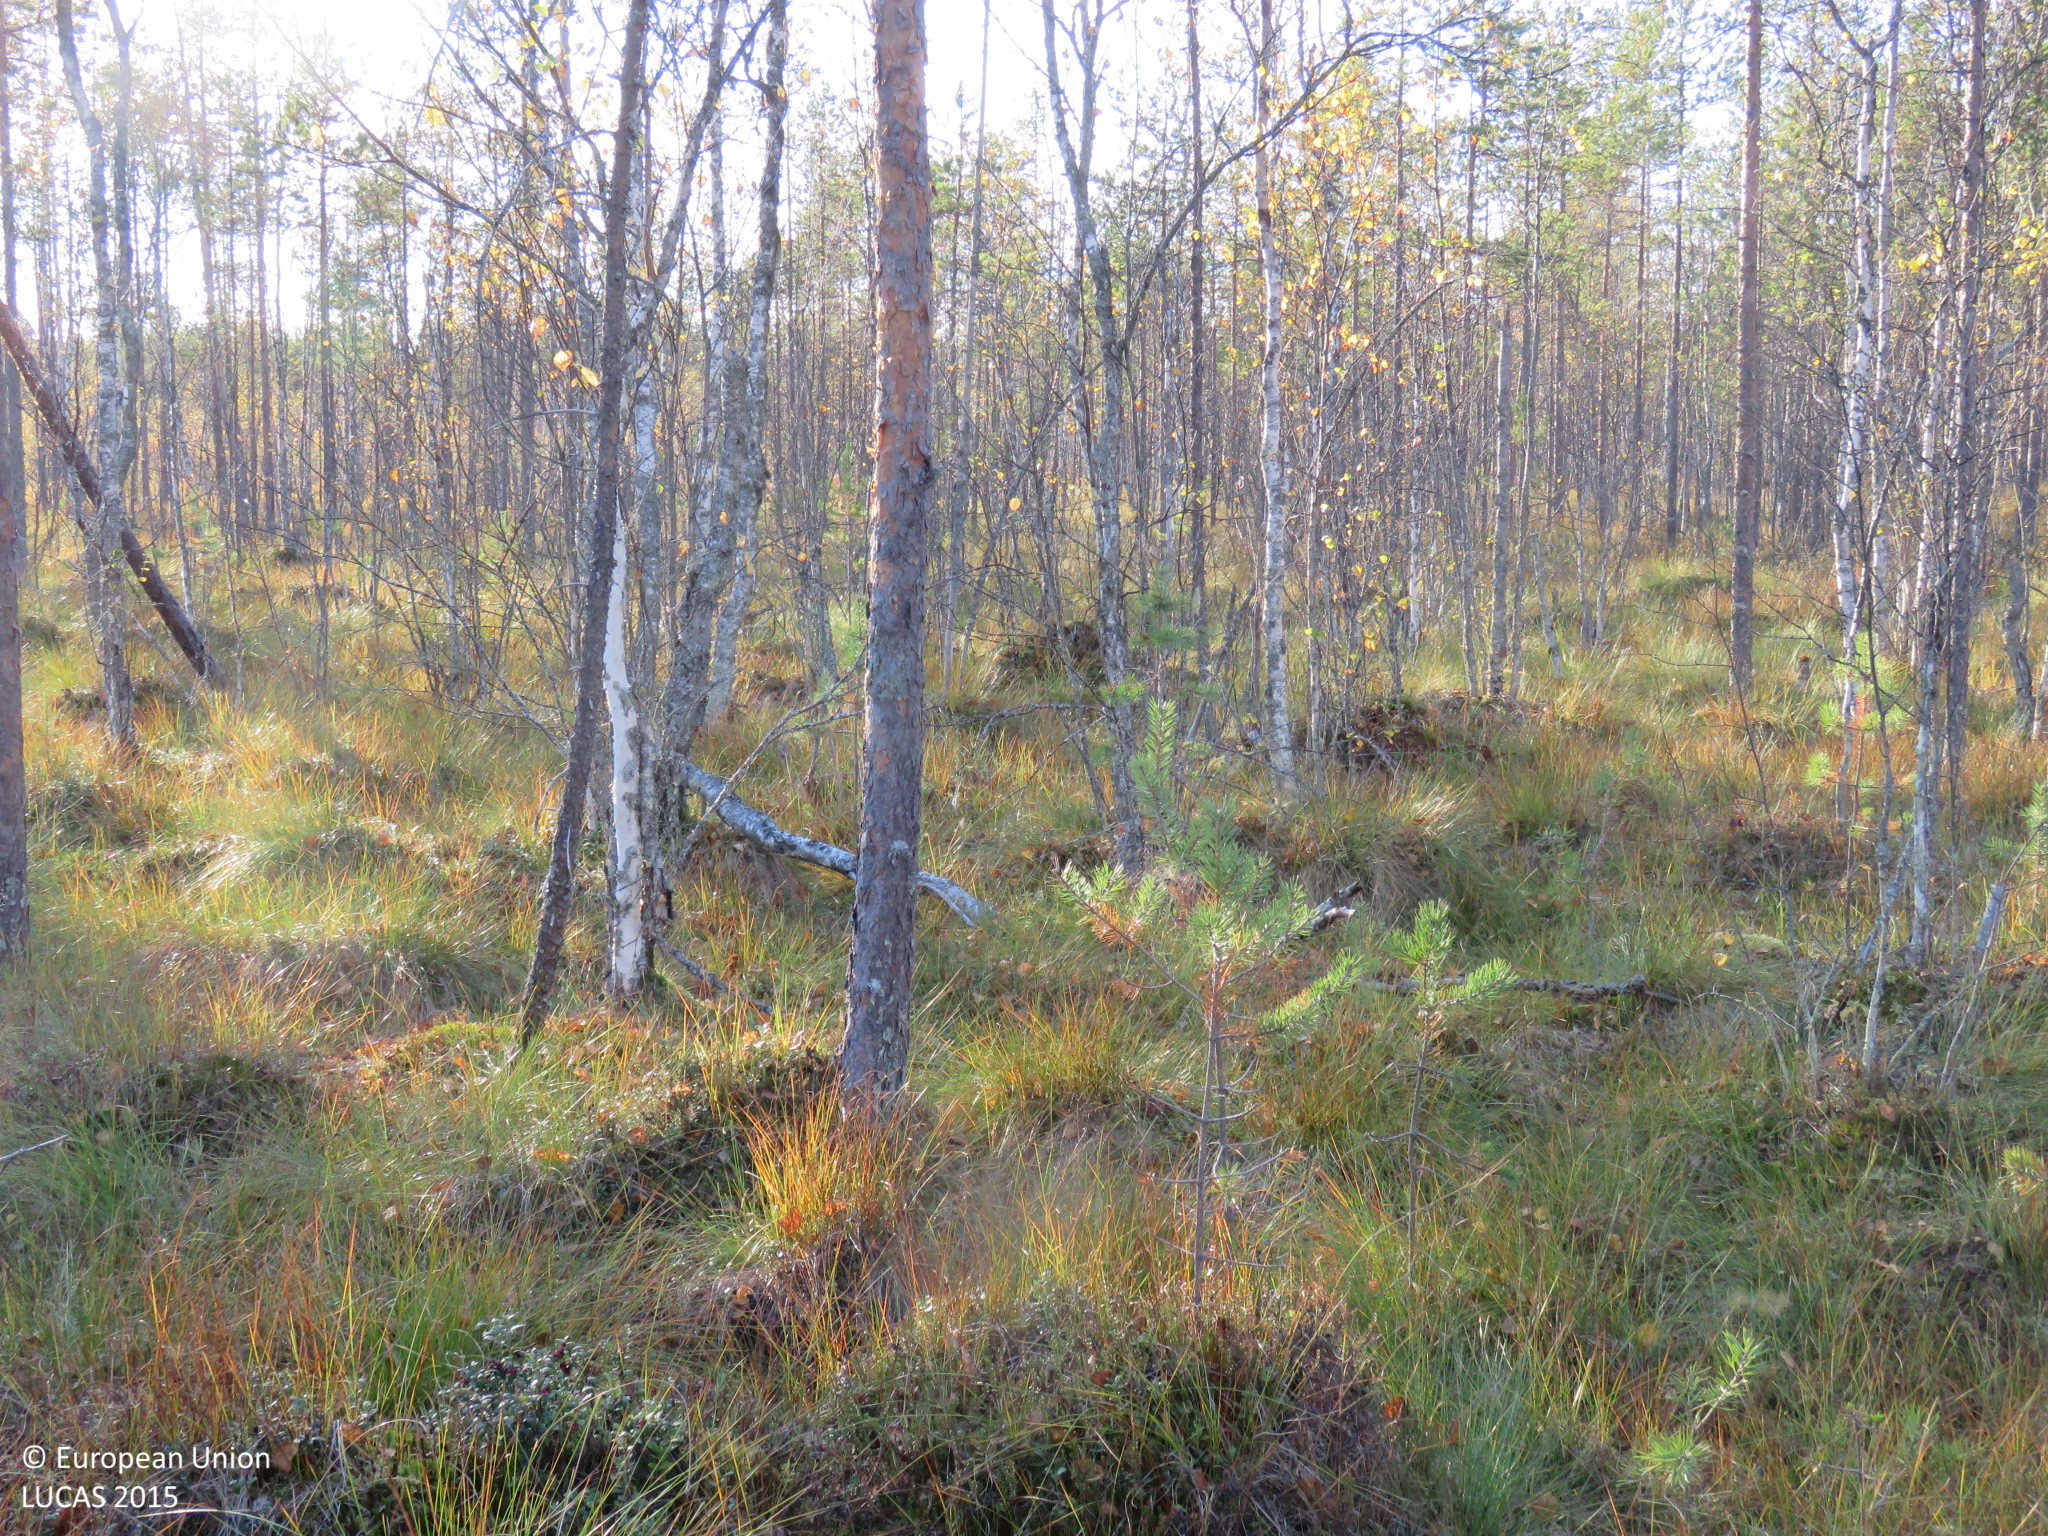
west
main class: Woodland
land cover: Pine dominated mixed woodland
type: mire and swamp forests
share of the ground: > 75 %
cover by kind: broadleaved forest trees 45 %, coniferous forest trees 35 %, shrubs 10 %, herbaceous plants 10 %
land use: Forestry
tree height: > 5 m
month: September
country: FI
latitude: 64.7648
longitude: 26.5302
